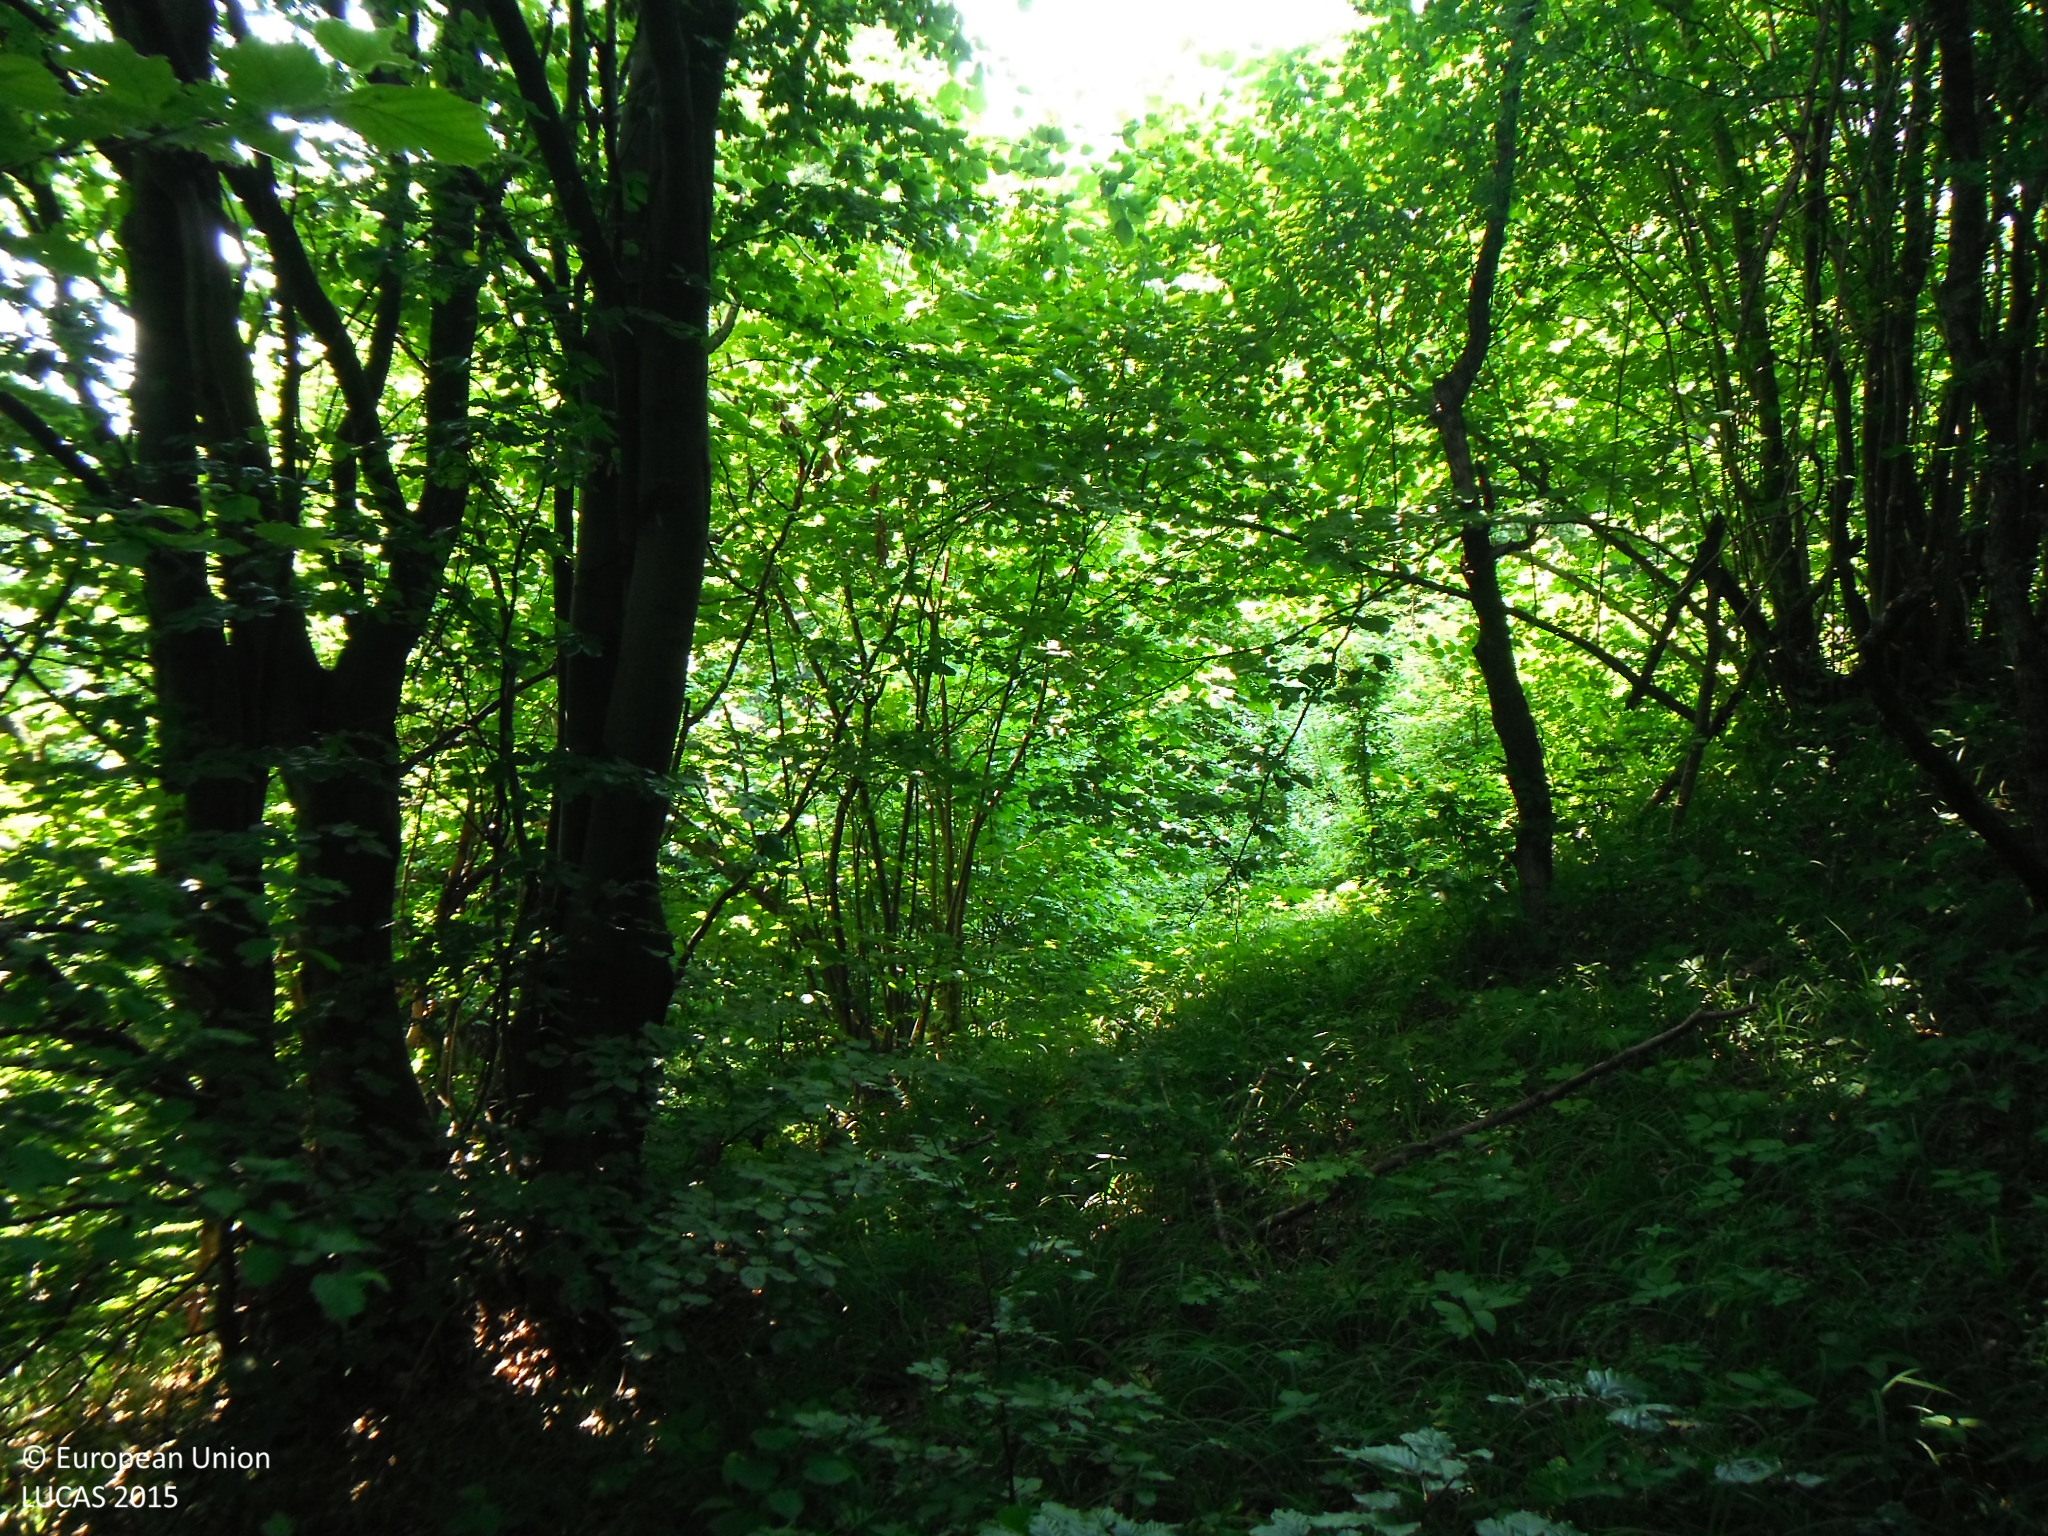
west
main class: Woodland
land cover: Broadleaved woodland
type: mesophytic deciduous forest
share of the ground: > 75 %
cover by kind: broadleaved forest trees 75 %, shrubs 25 %
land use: Forestry
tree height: > 5 m
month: July
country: SK
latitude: 49.1930
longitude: 21.0342
